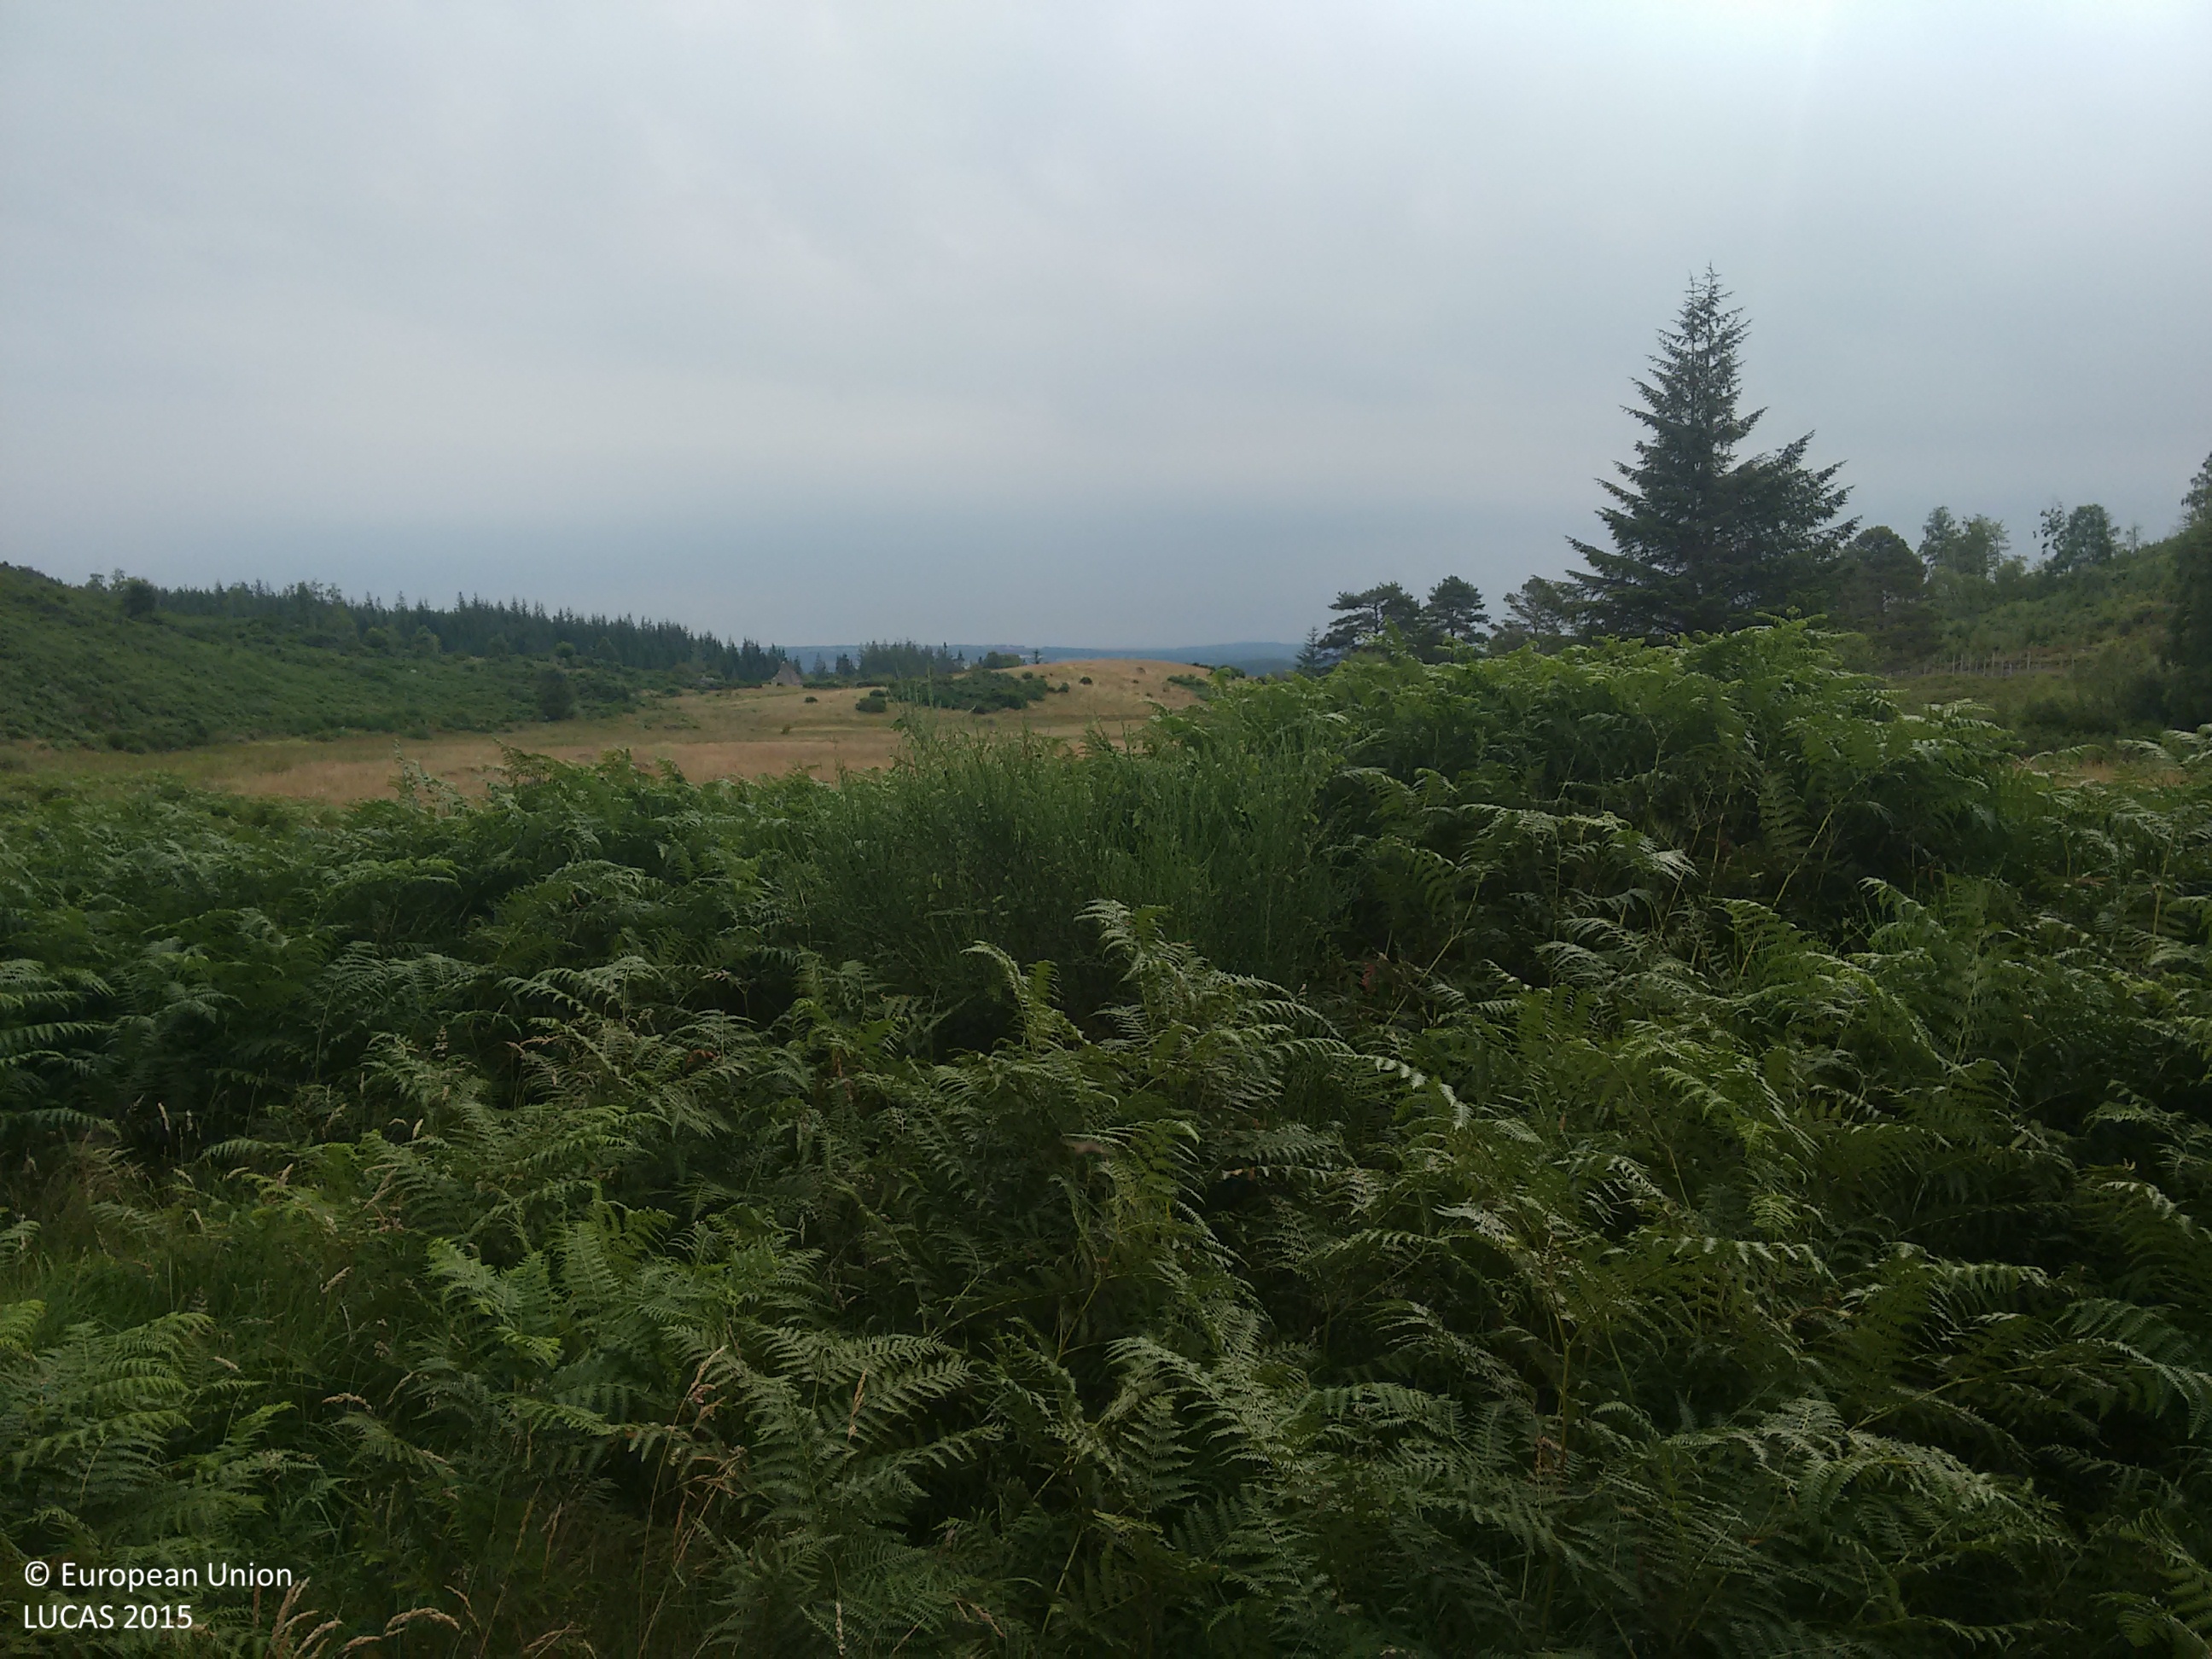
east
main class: Grassland
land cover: Grassland without tree/shrub cover
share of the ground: > 75 %
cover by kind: herbaceous plants 100 %
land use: Agriculture (excluding fallow land and kitchen gardens)
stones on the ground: < 10 %
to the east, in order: Grassland without tree/shrub cover; Inland marshes; Grassland without tree/shrub cover; Inland marshes
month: August
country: GB
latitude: 57.5291
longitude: -4.5718
